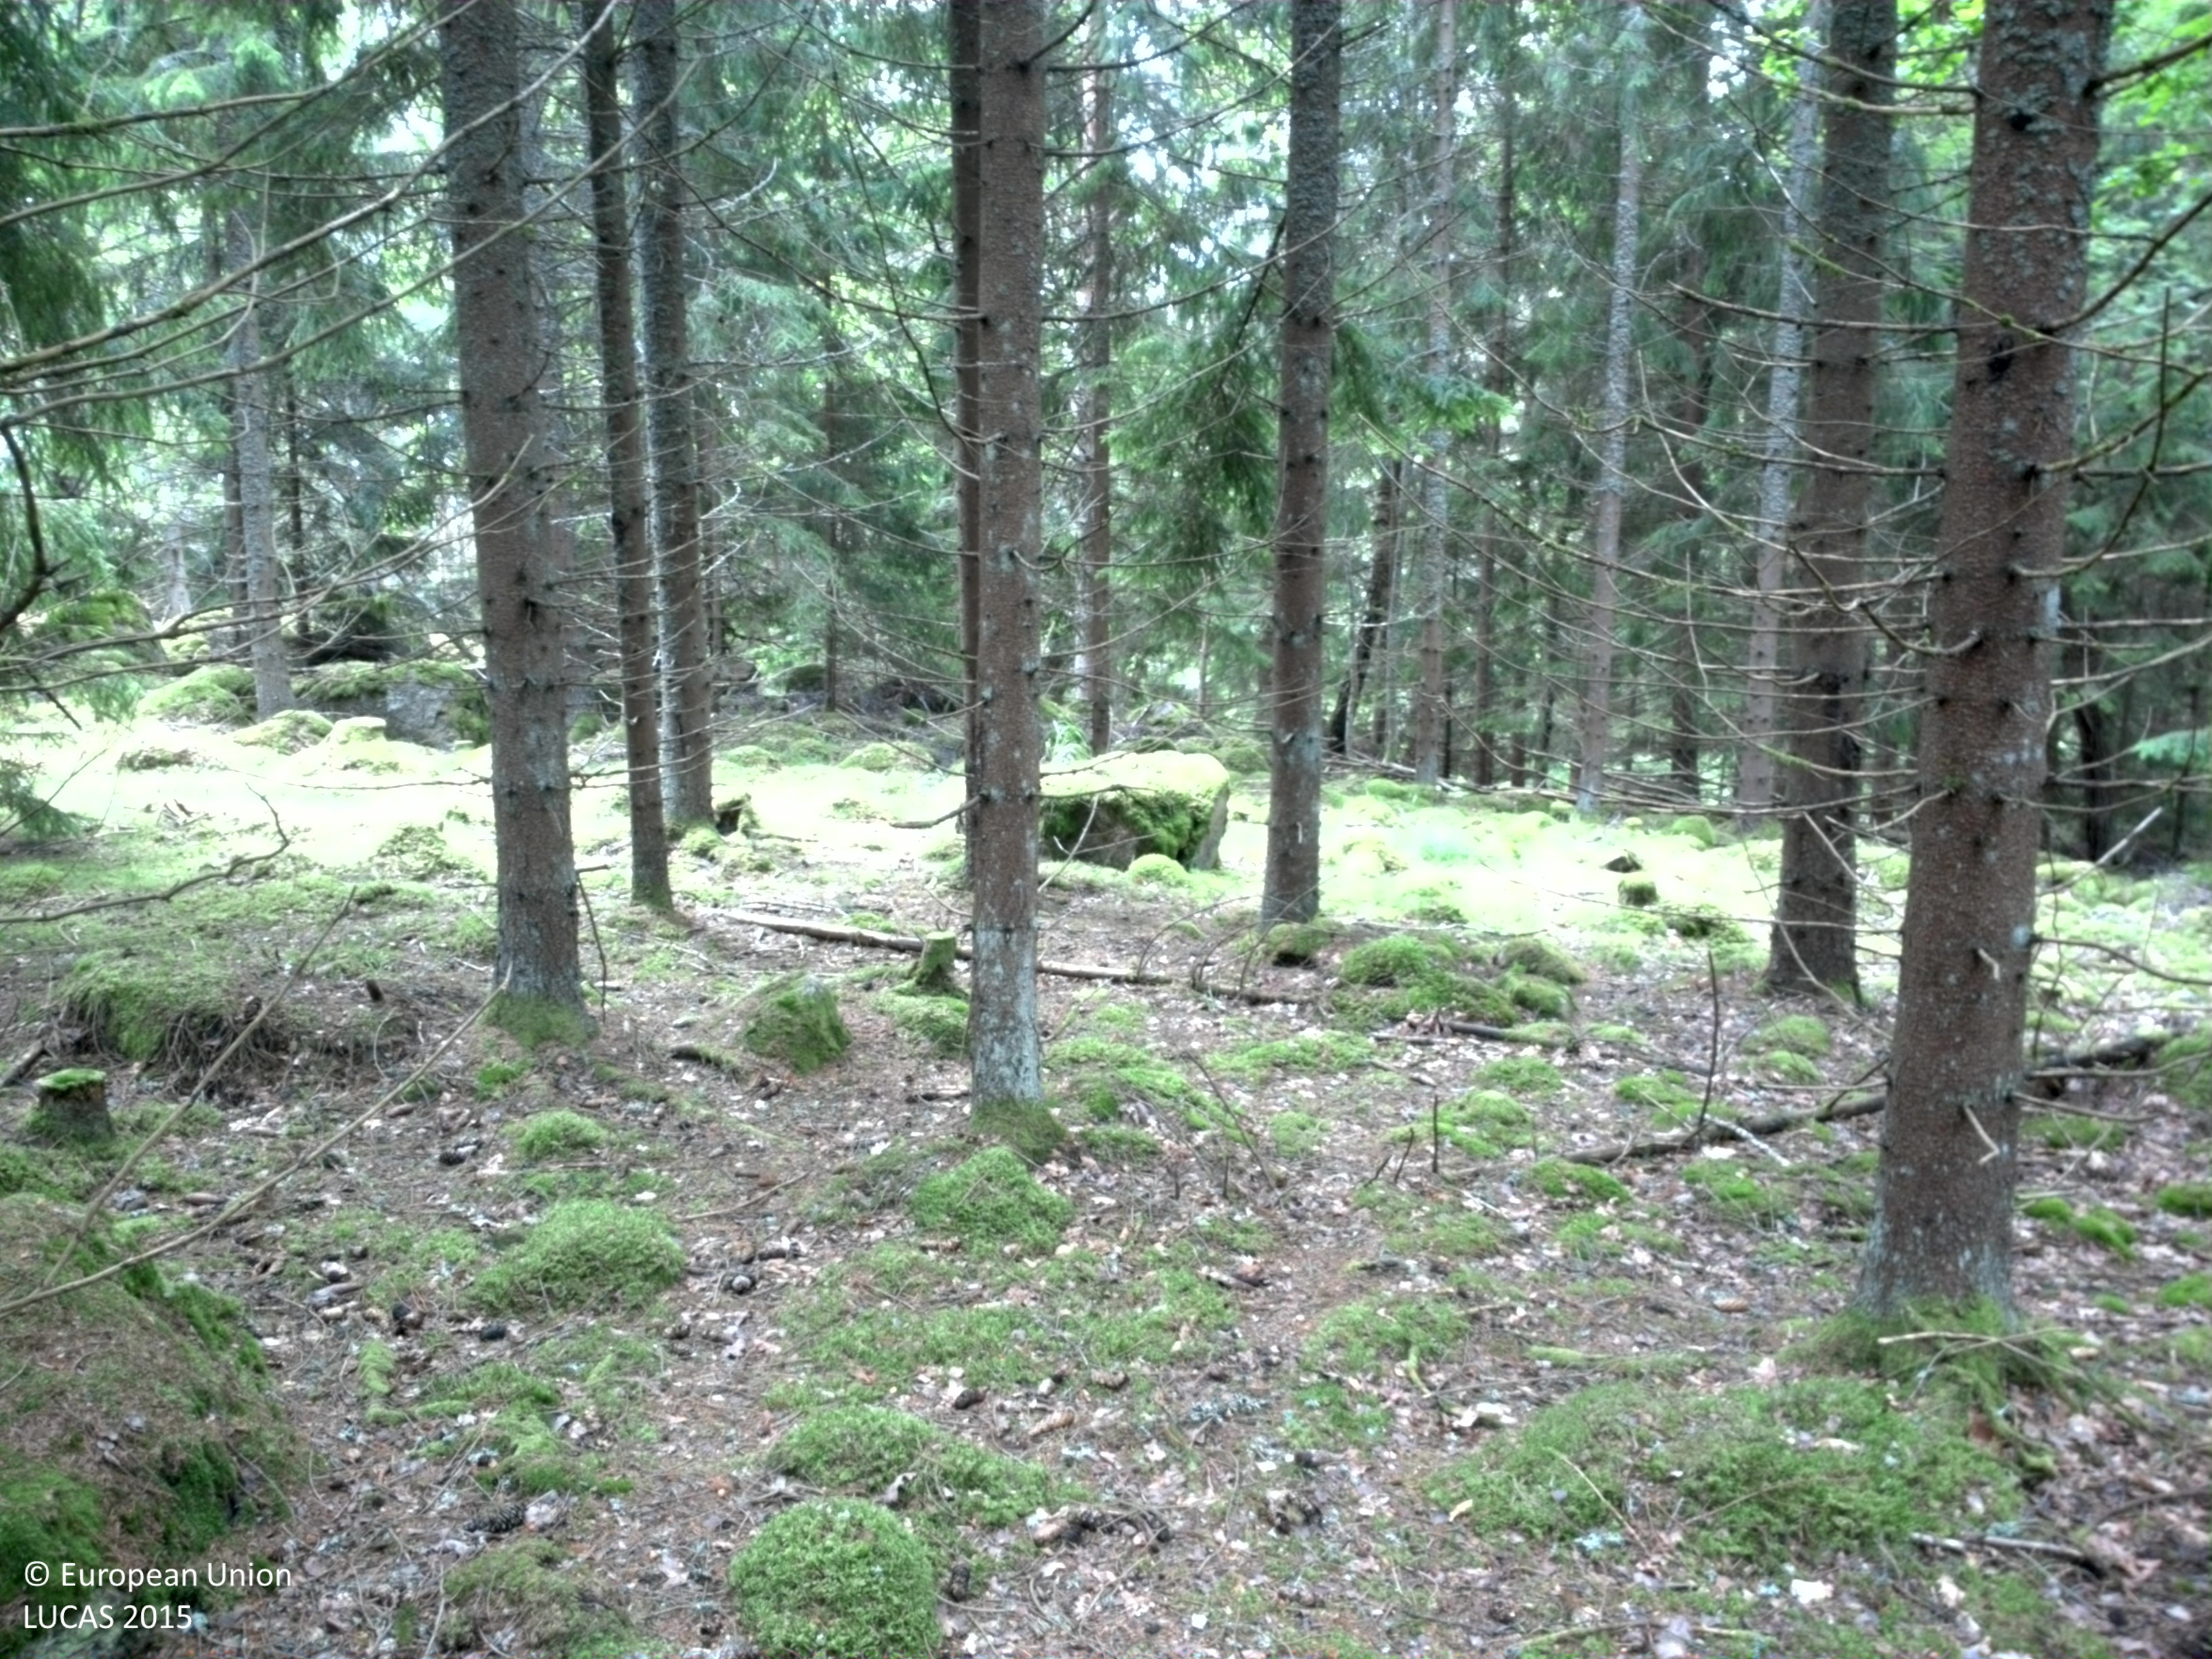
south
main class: Woodland
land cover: Spruce dominated coniferous woodland
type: boreal forest
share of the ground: 50 - 75 %
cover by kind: coniferous forest trees 70 %, lichens and mosses 30 %
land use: Forestry
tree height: > 5 m
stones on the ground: 10 - 25 %
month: June
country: SE
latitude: 58.5367
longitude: 15.5767
